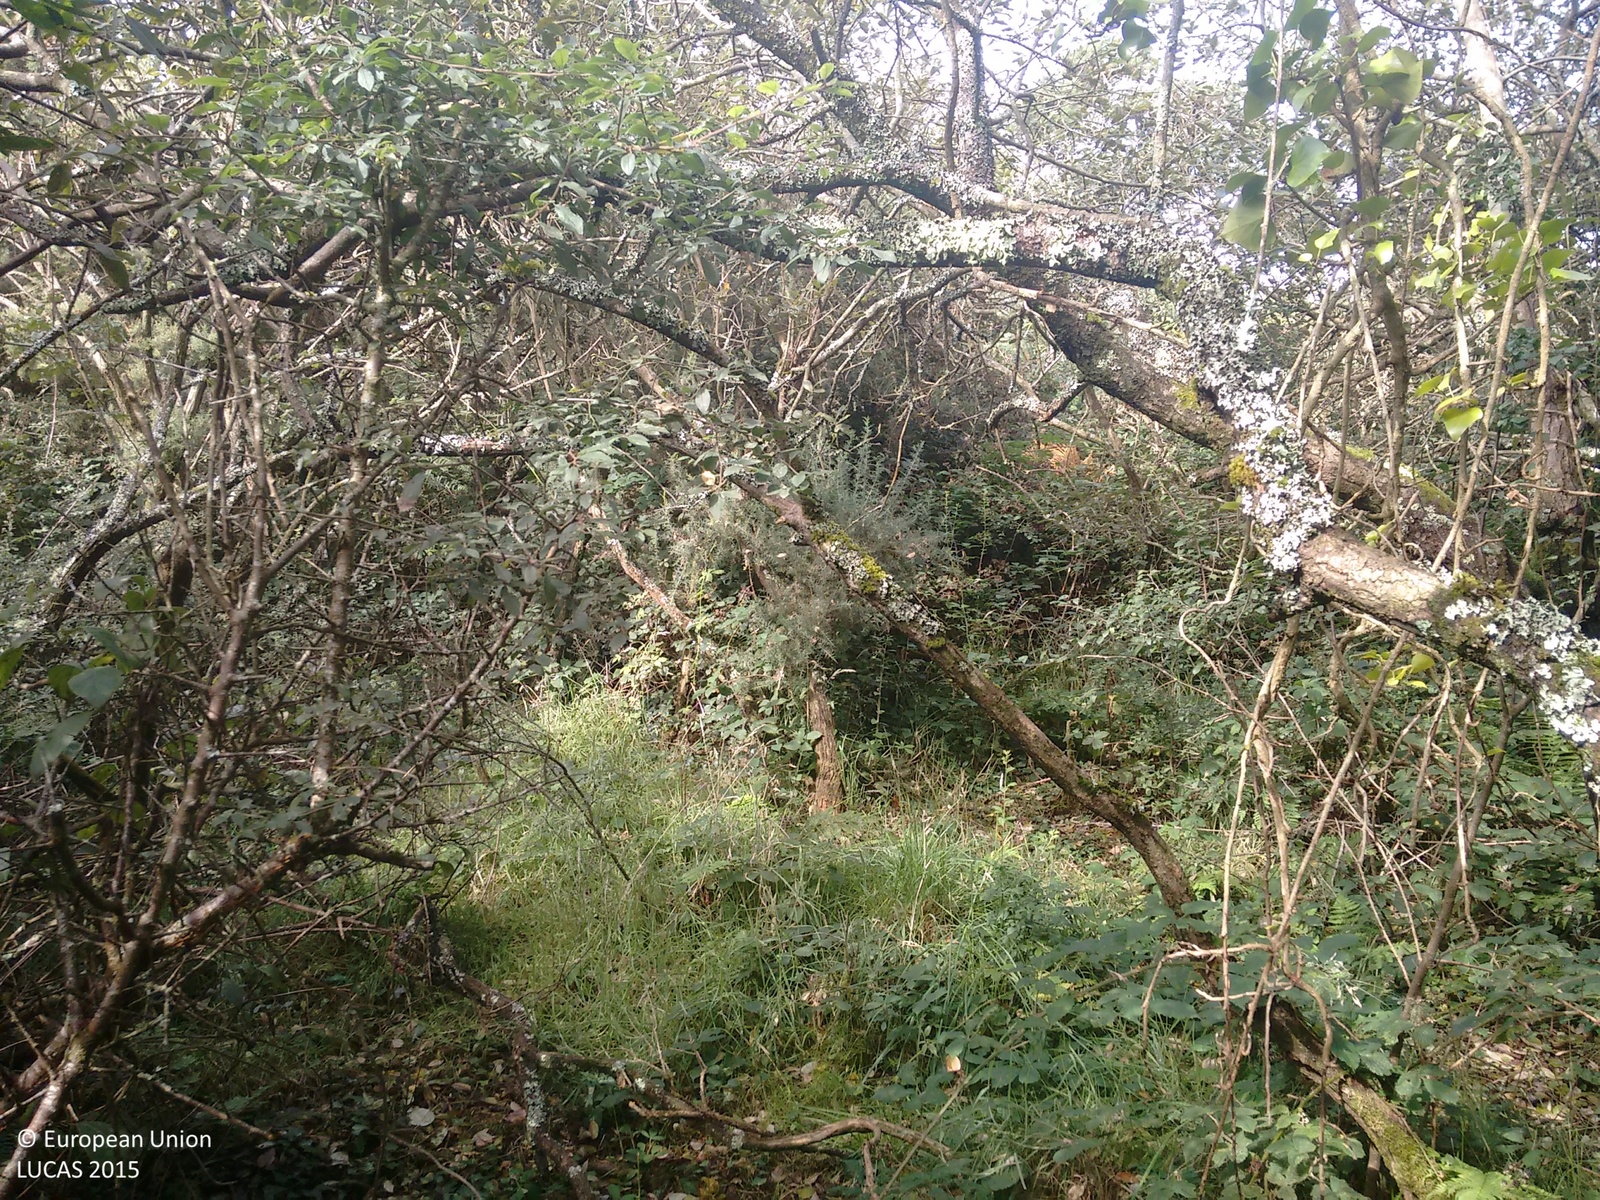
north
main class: Woodland
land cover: Broadleaved woodland
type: mesophytic deciduous forest
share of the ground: > 75 %
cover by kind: broadleaved forest trees 100 %
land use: Forestry
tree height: > 5 m
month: August
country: GB
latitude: 49.9990
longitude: -5.2007
